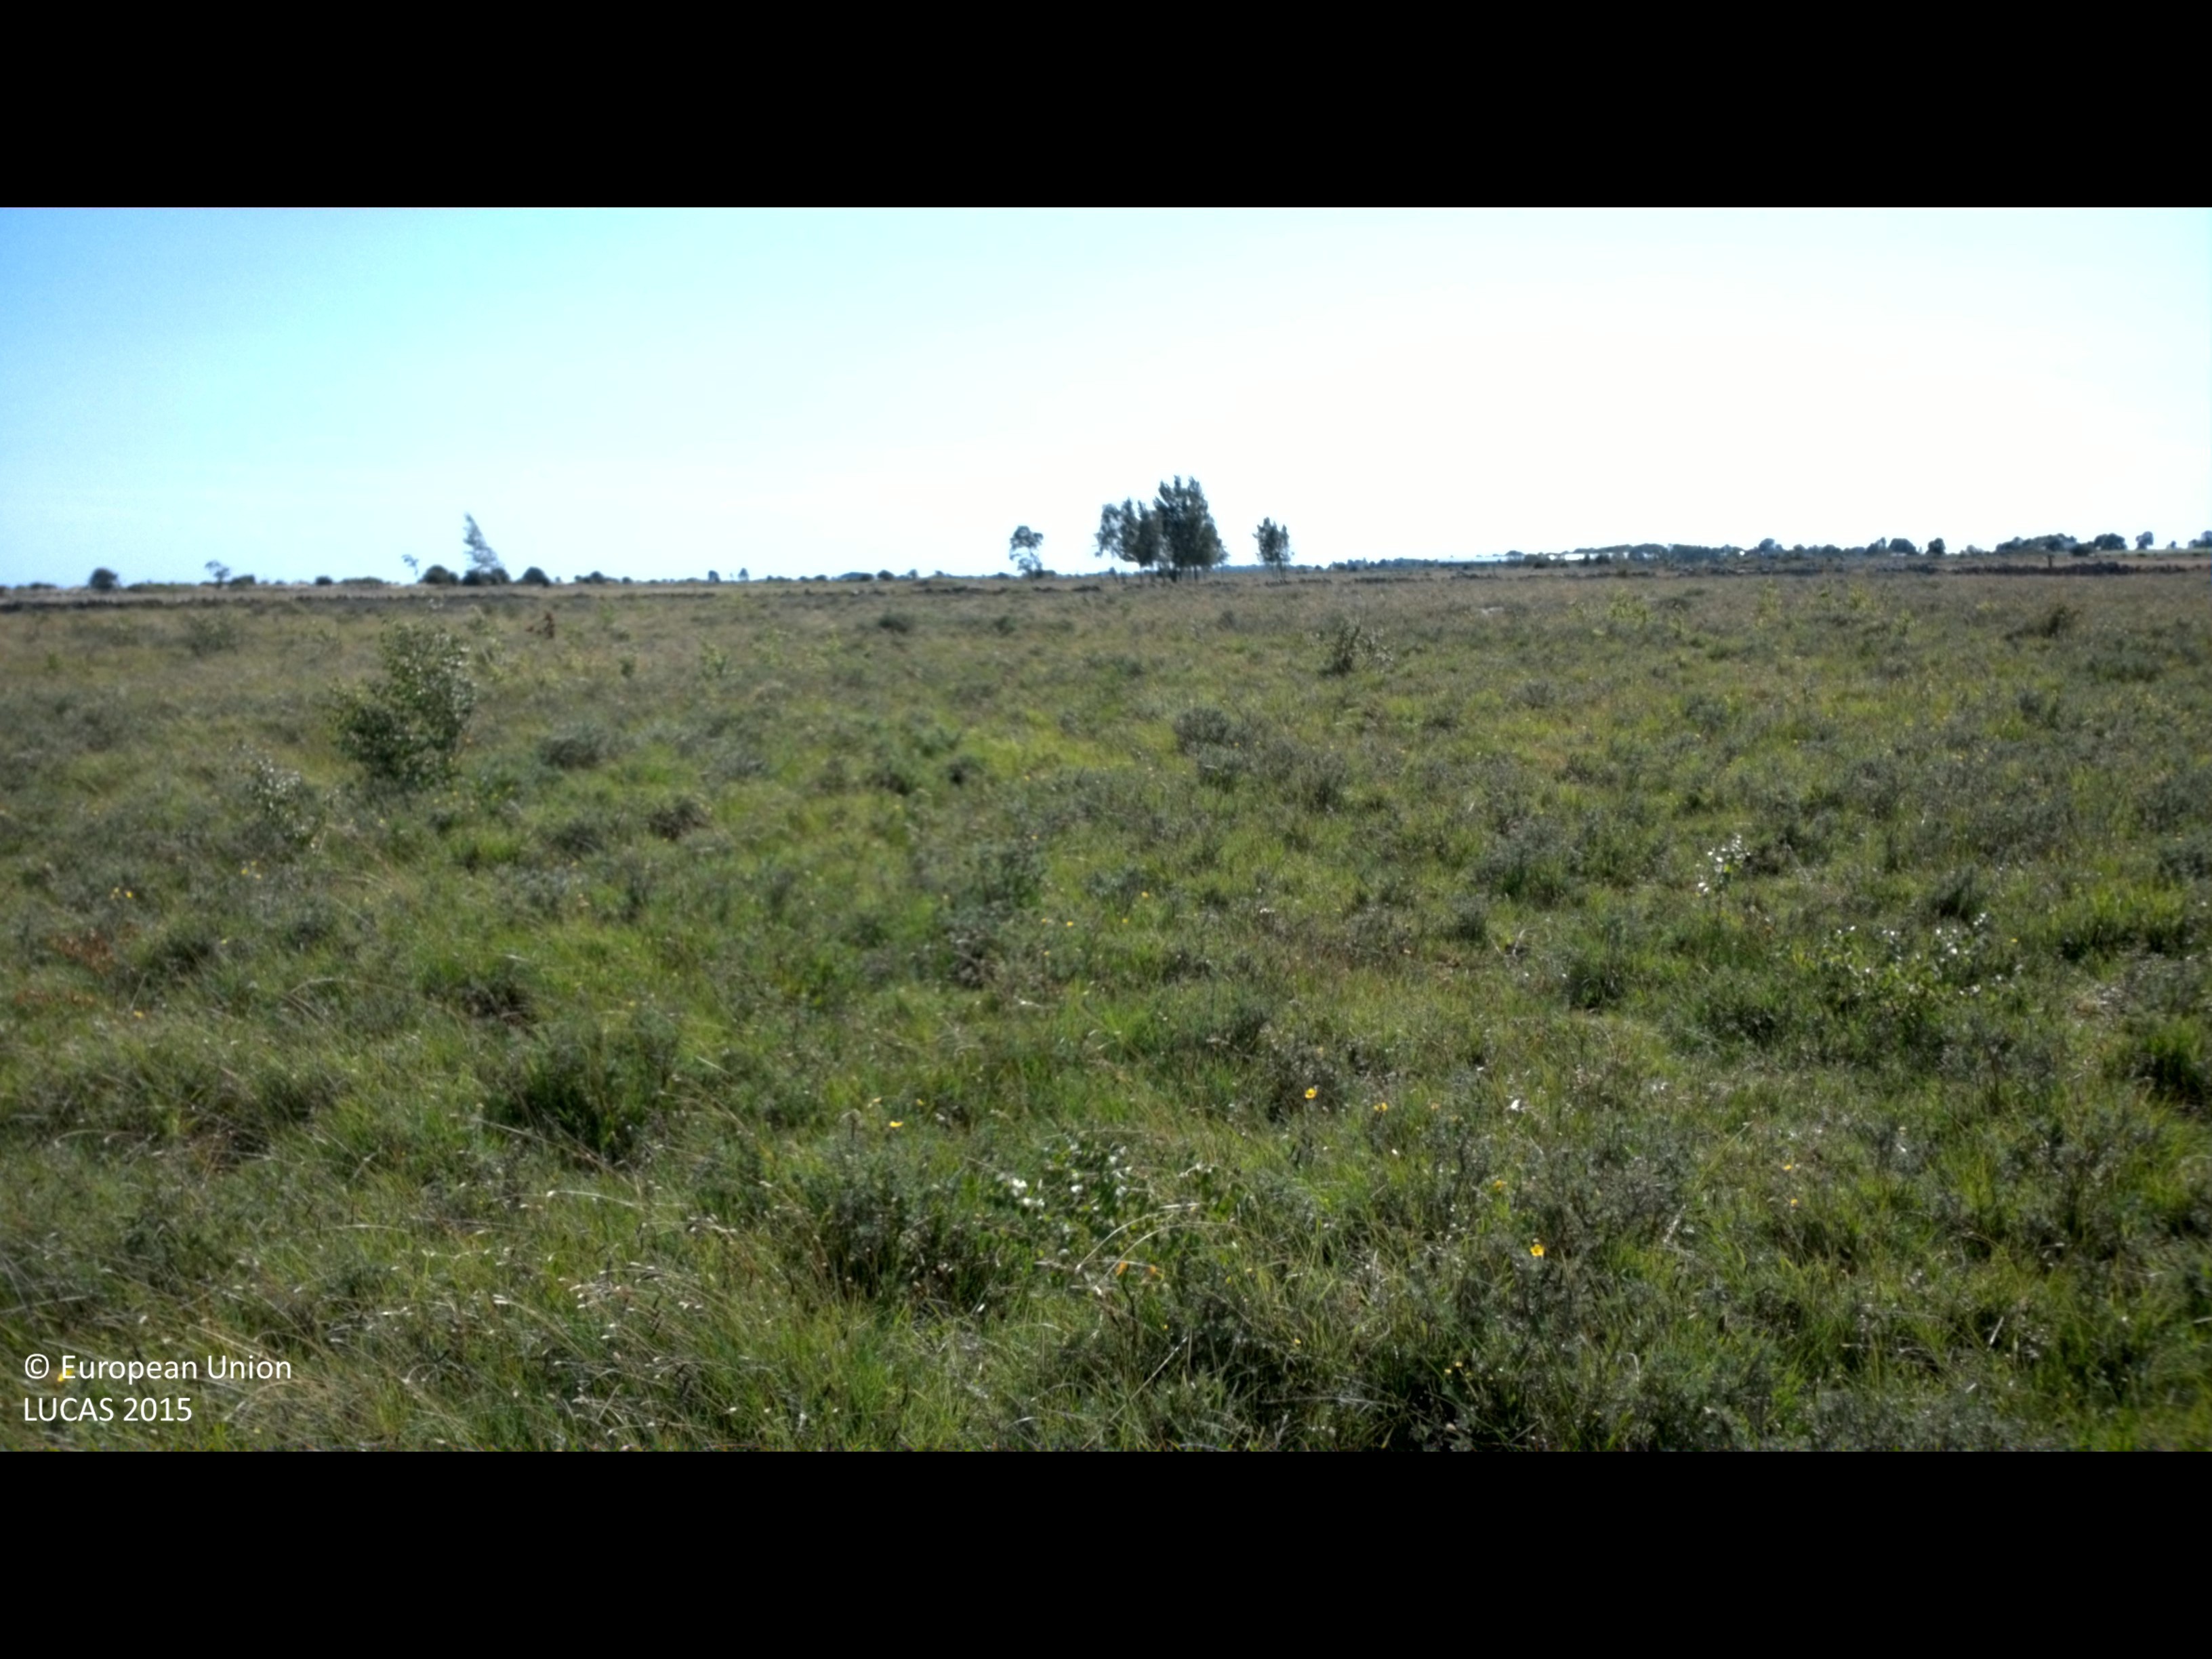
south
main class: Grassland
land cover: Grassland with sparse tree/shrub cover
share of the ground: > 75 %
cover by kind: herbaceous plants 90 %, broadleaved forest trees 5 %, shrubs 5 %
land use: Agriculture (excluding fallow land and kitchen gardens)
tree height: < 5 m
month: July
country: SE
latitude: 56.4344
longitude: 16.5702
